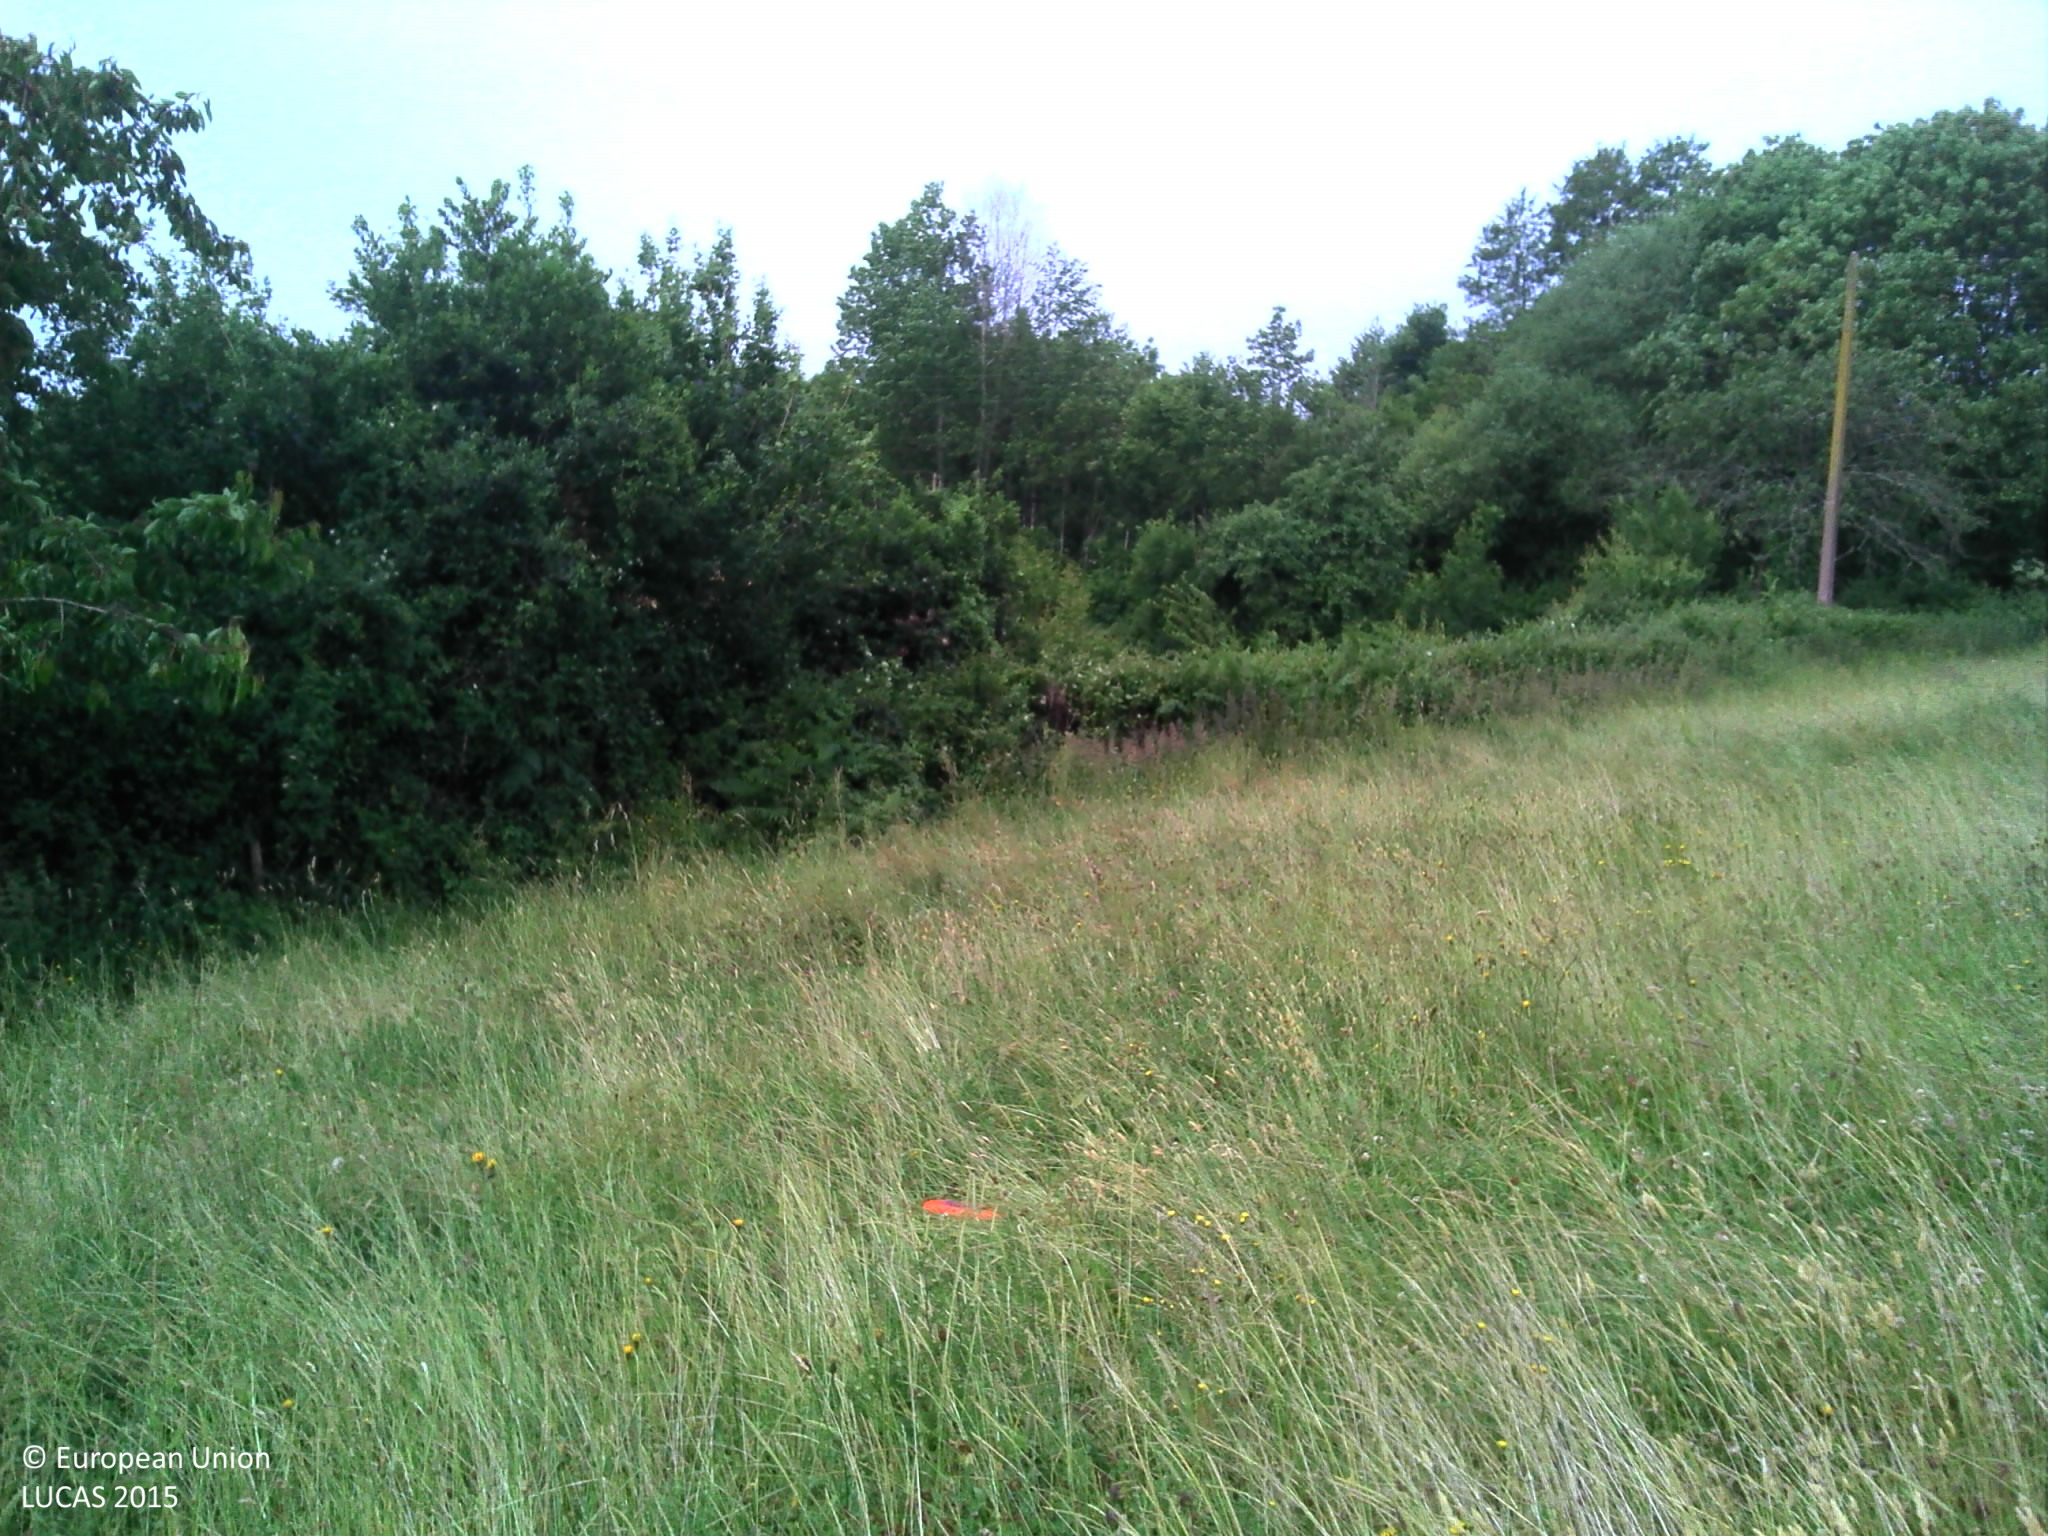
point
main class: Grassland
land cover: Grassland without tree/shrub cover
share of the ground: > 75 %
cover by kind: herbaceous plants 100 %
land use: Agriculture (excluding fallow land and kitchen gardens)
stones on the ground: < 10 %
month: June
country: FR
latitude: 48.3405
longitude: -0.0810
